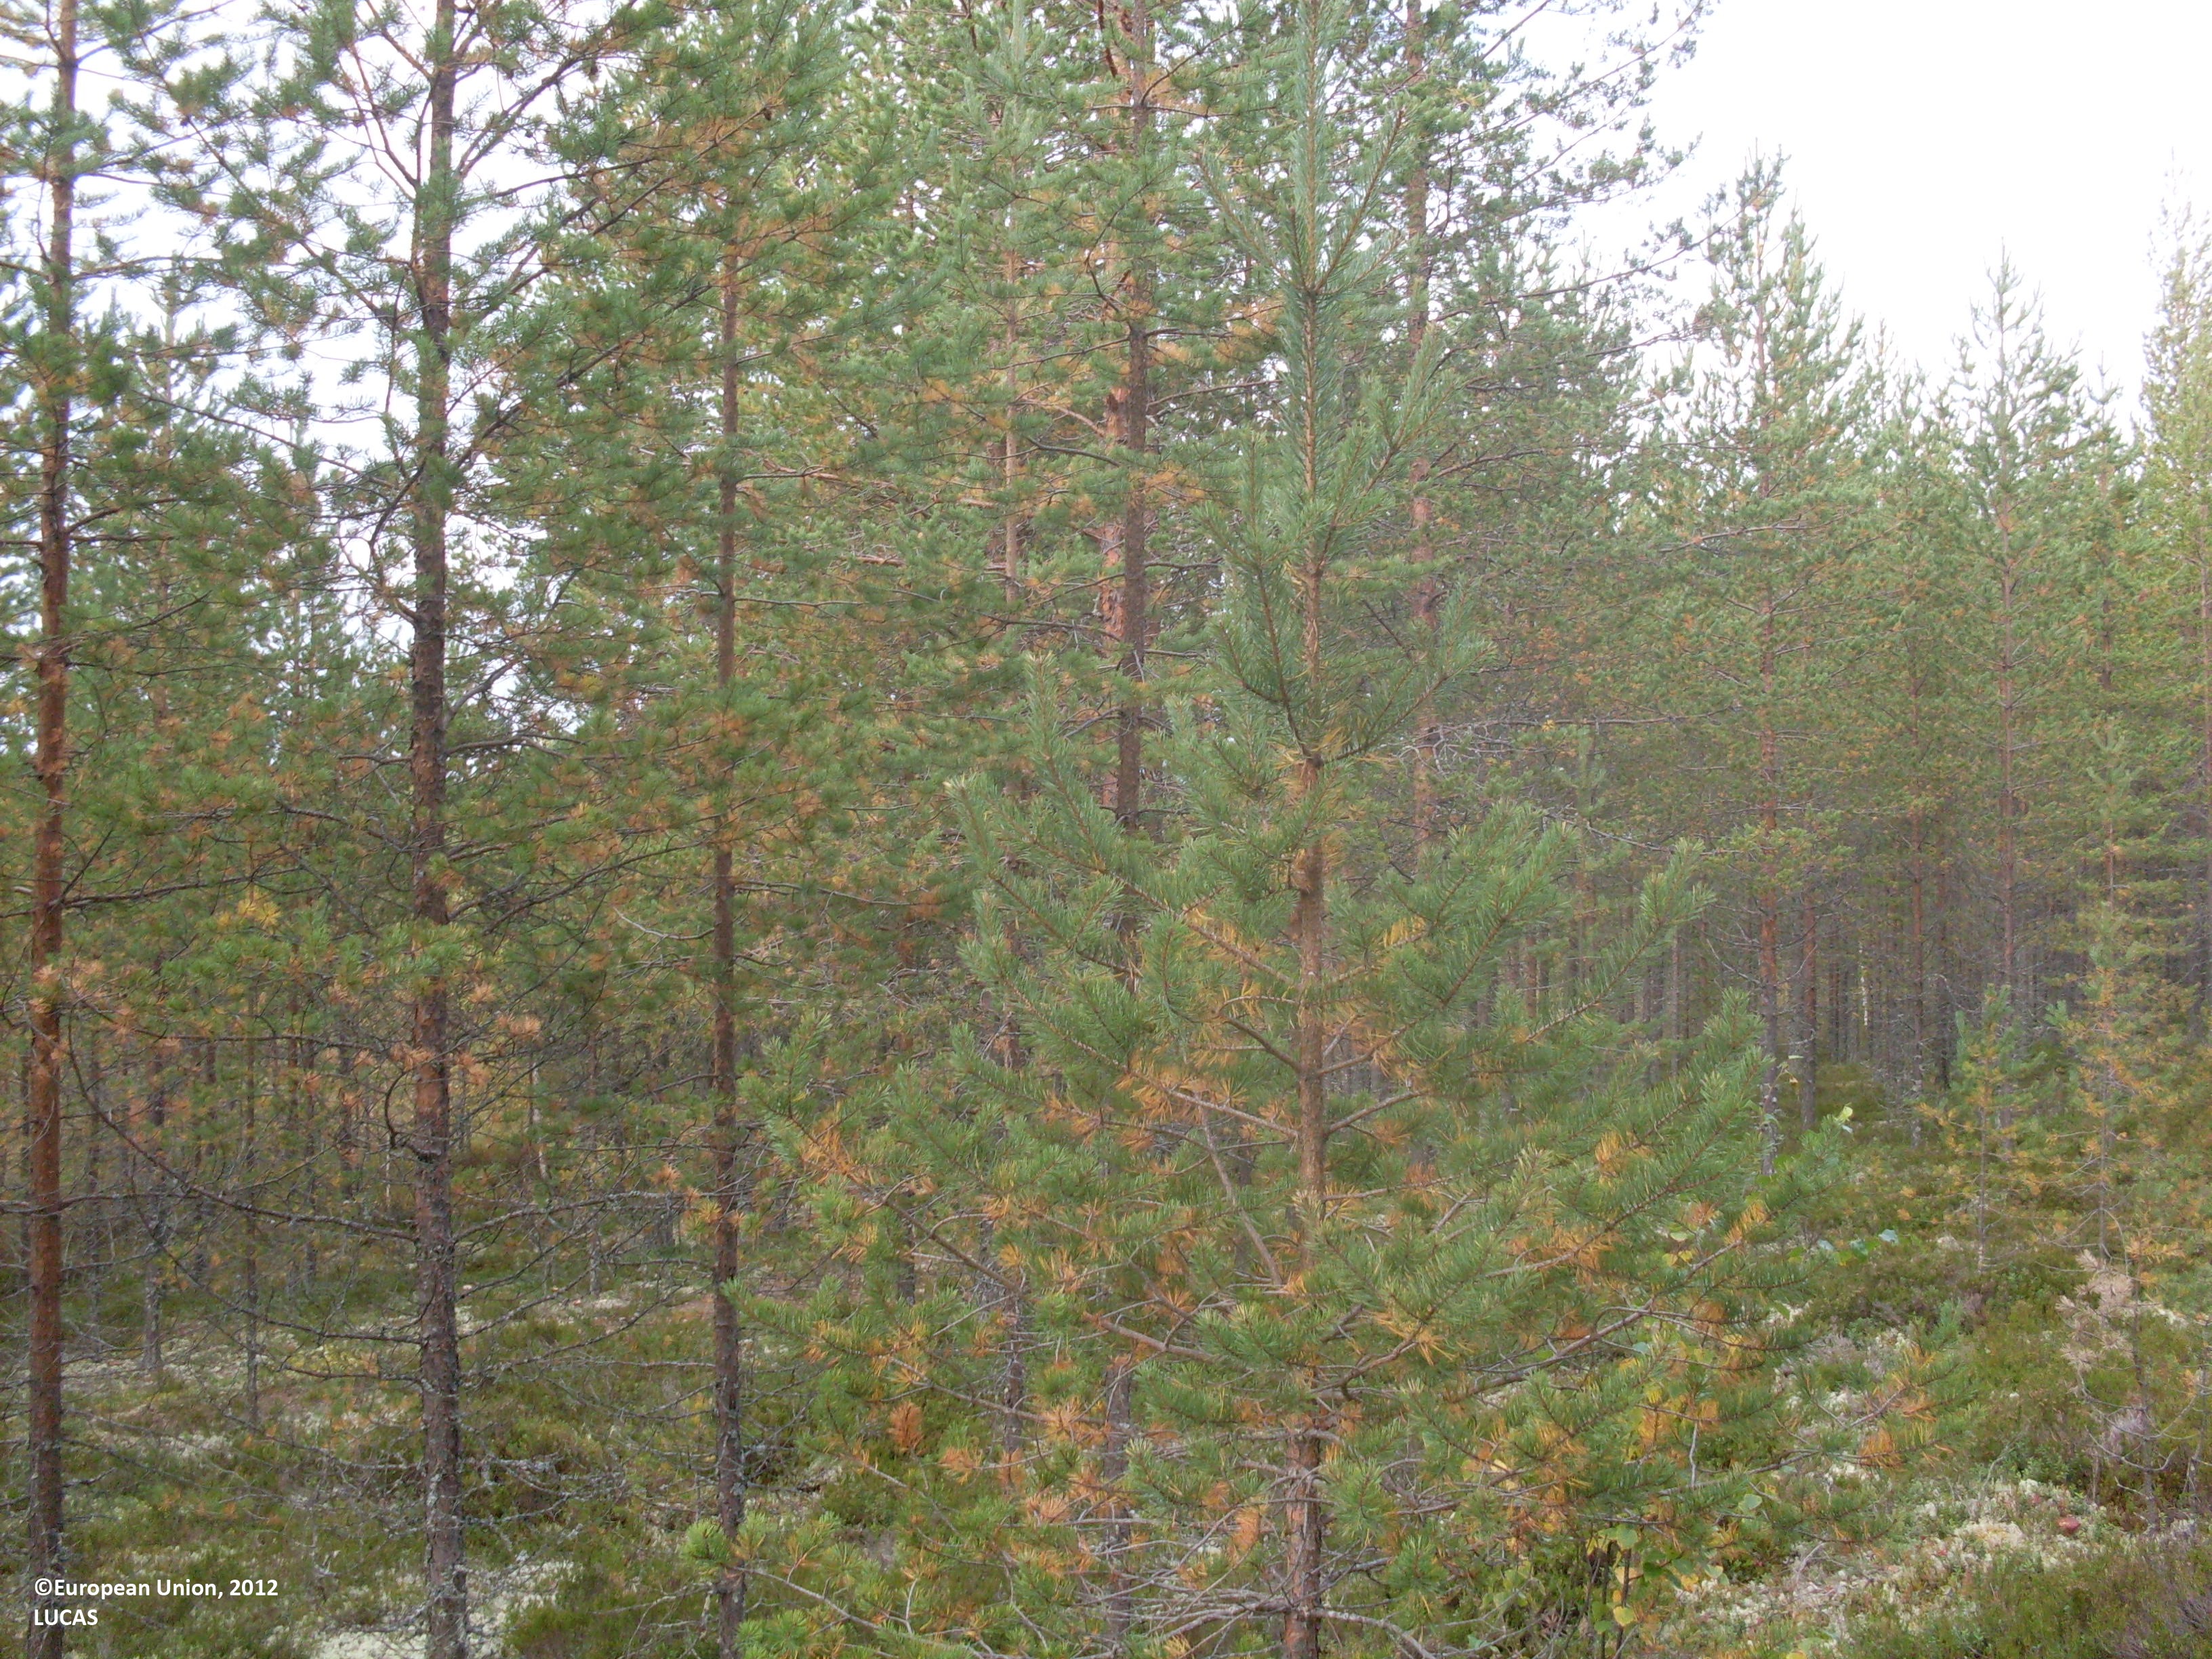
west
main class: Woodland
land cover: Pine dominated coniferous woodland
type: boreal forest
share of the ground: 50 - 75 %
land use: Forestry
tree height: > 5 m
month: September
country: FI
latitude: 64.0789
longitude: 29.5566
